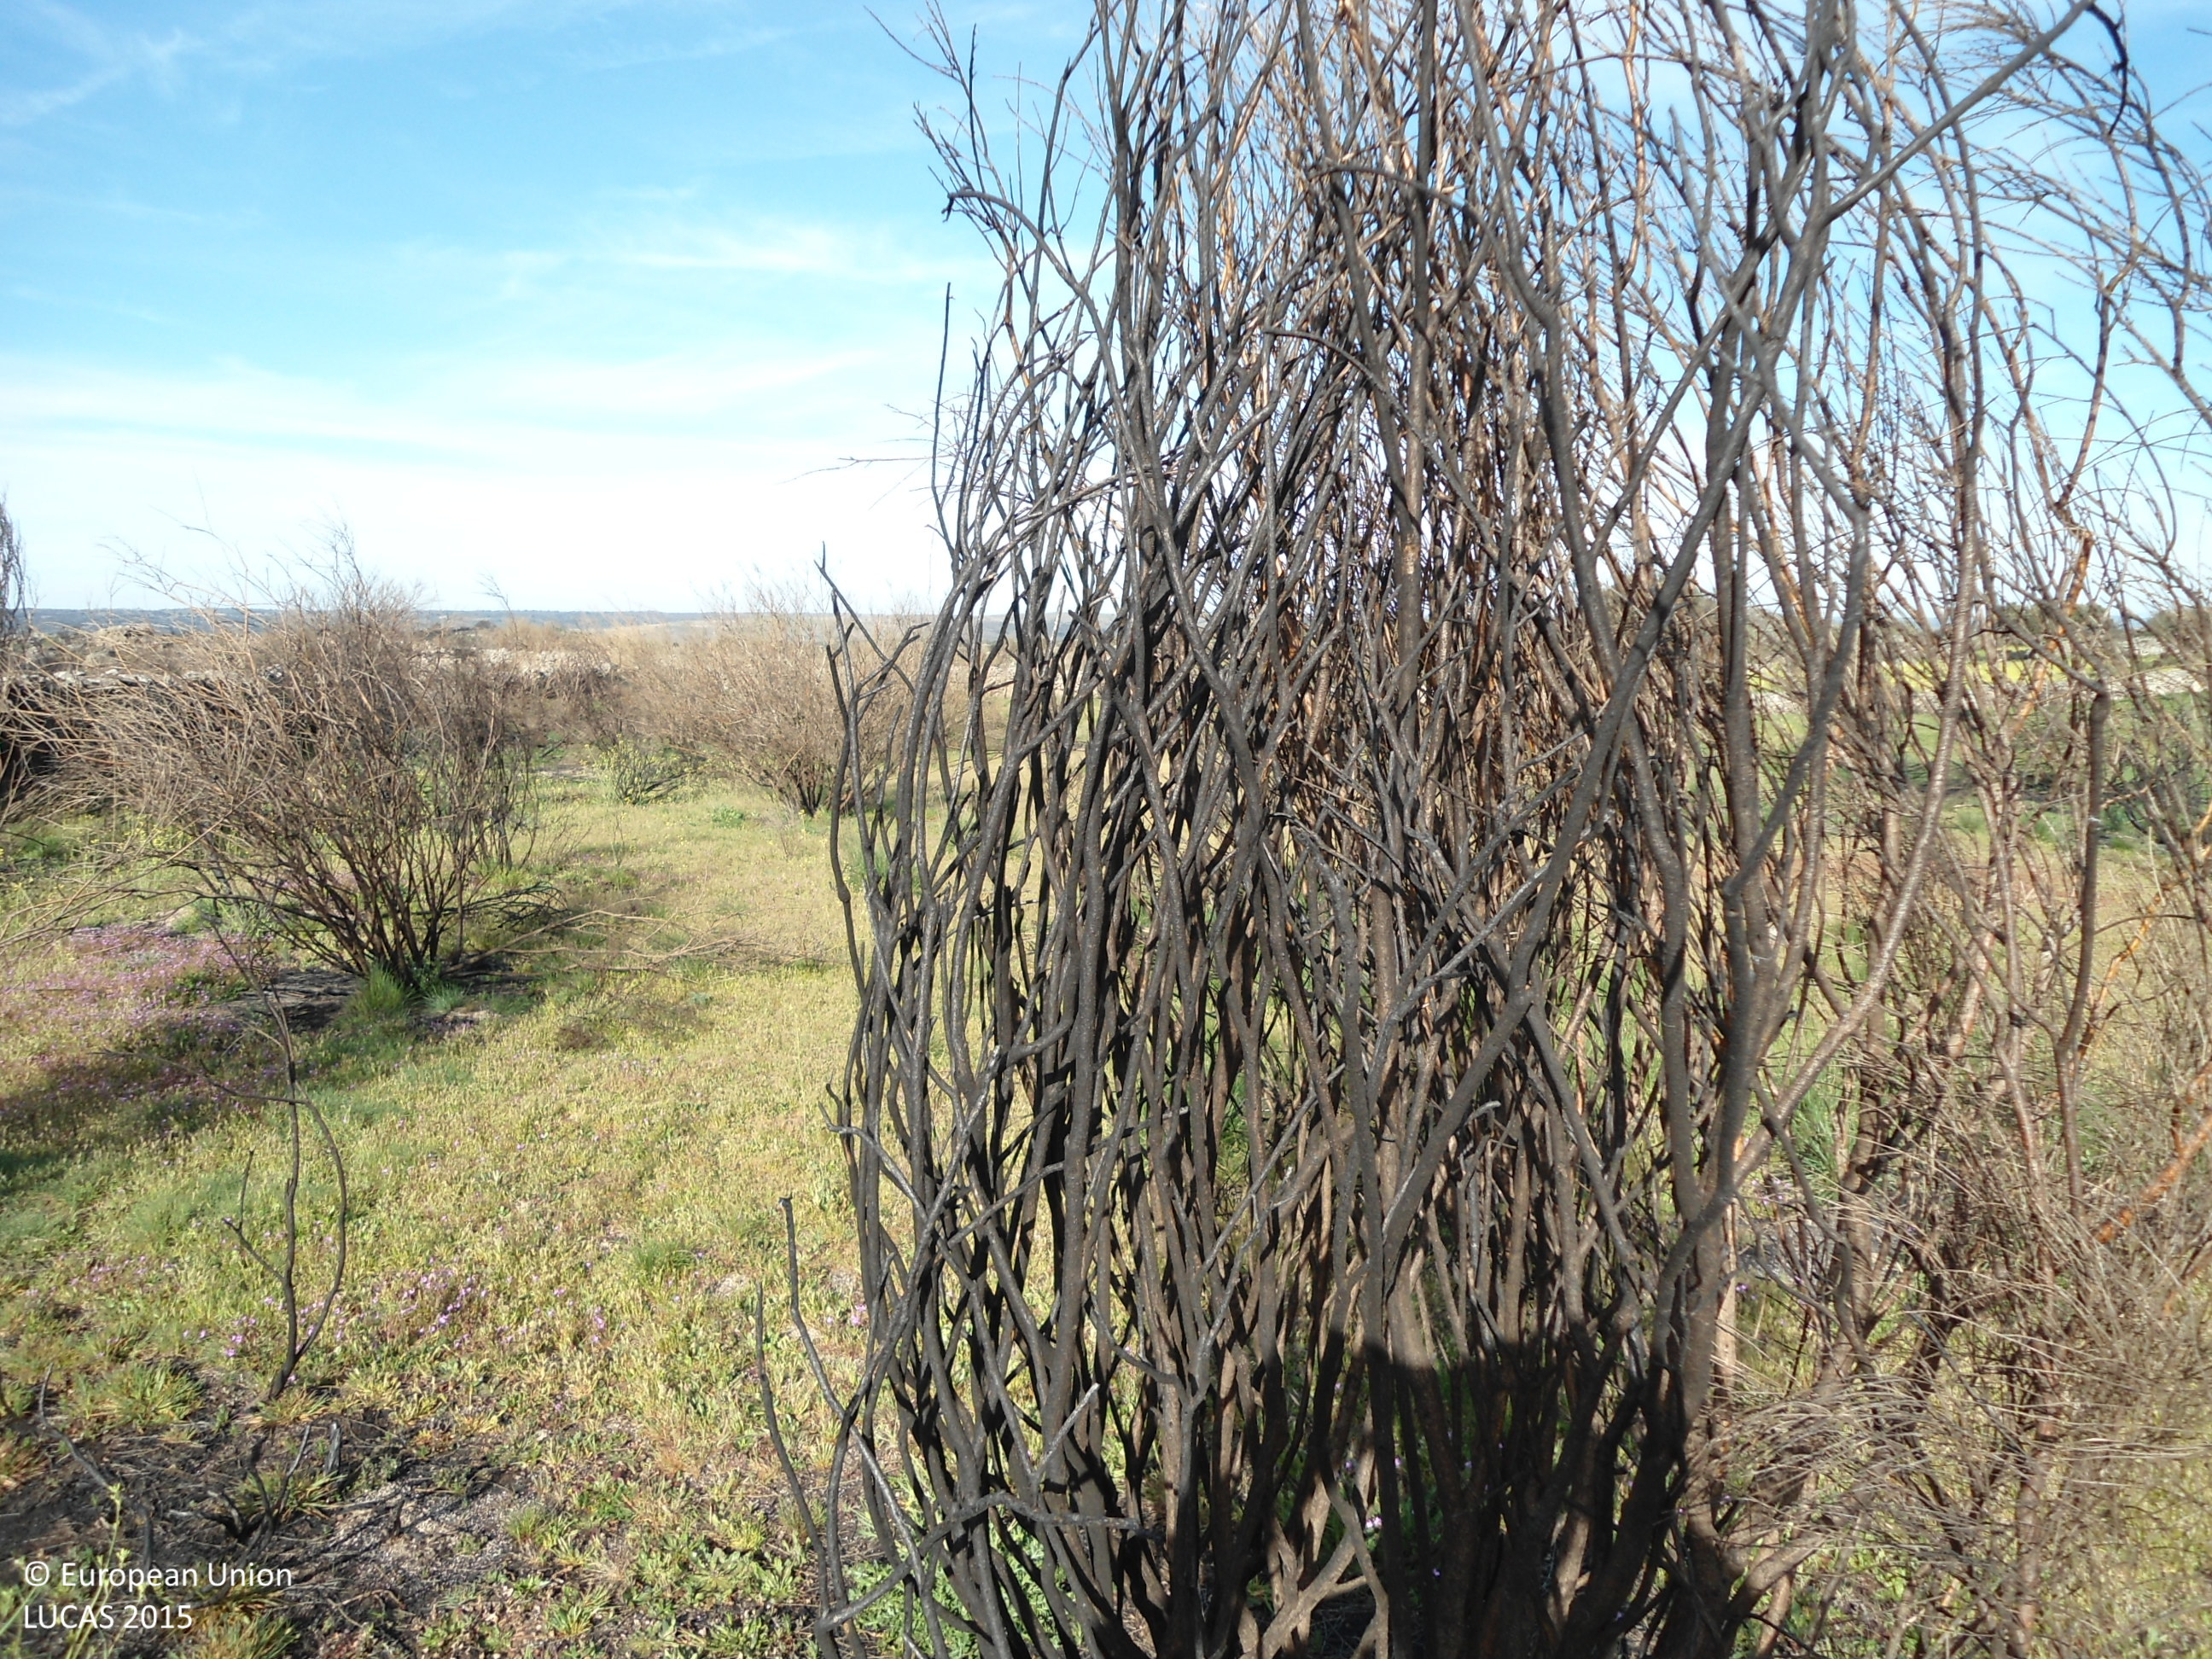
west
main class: Grassland
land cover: Grassland without tree/shrub cover
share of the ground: > 75 %
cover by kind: herbaceous plants 100 %
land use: Agriculture (excluding fallow land and kitchen gardens)
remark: Burnt area
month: April
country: ES
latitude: 41.5267
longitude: -6.0687
